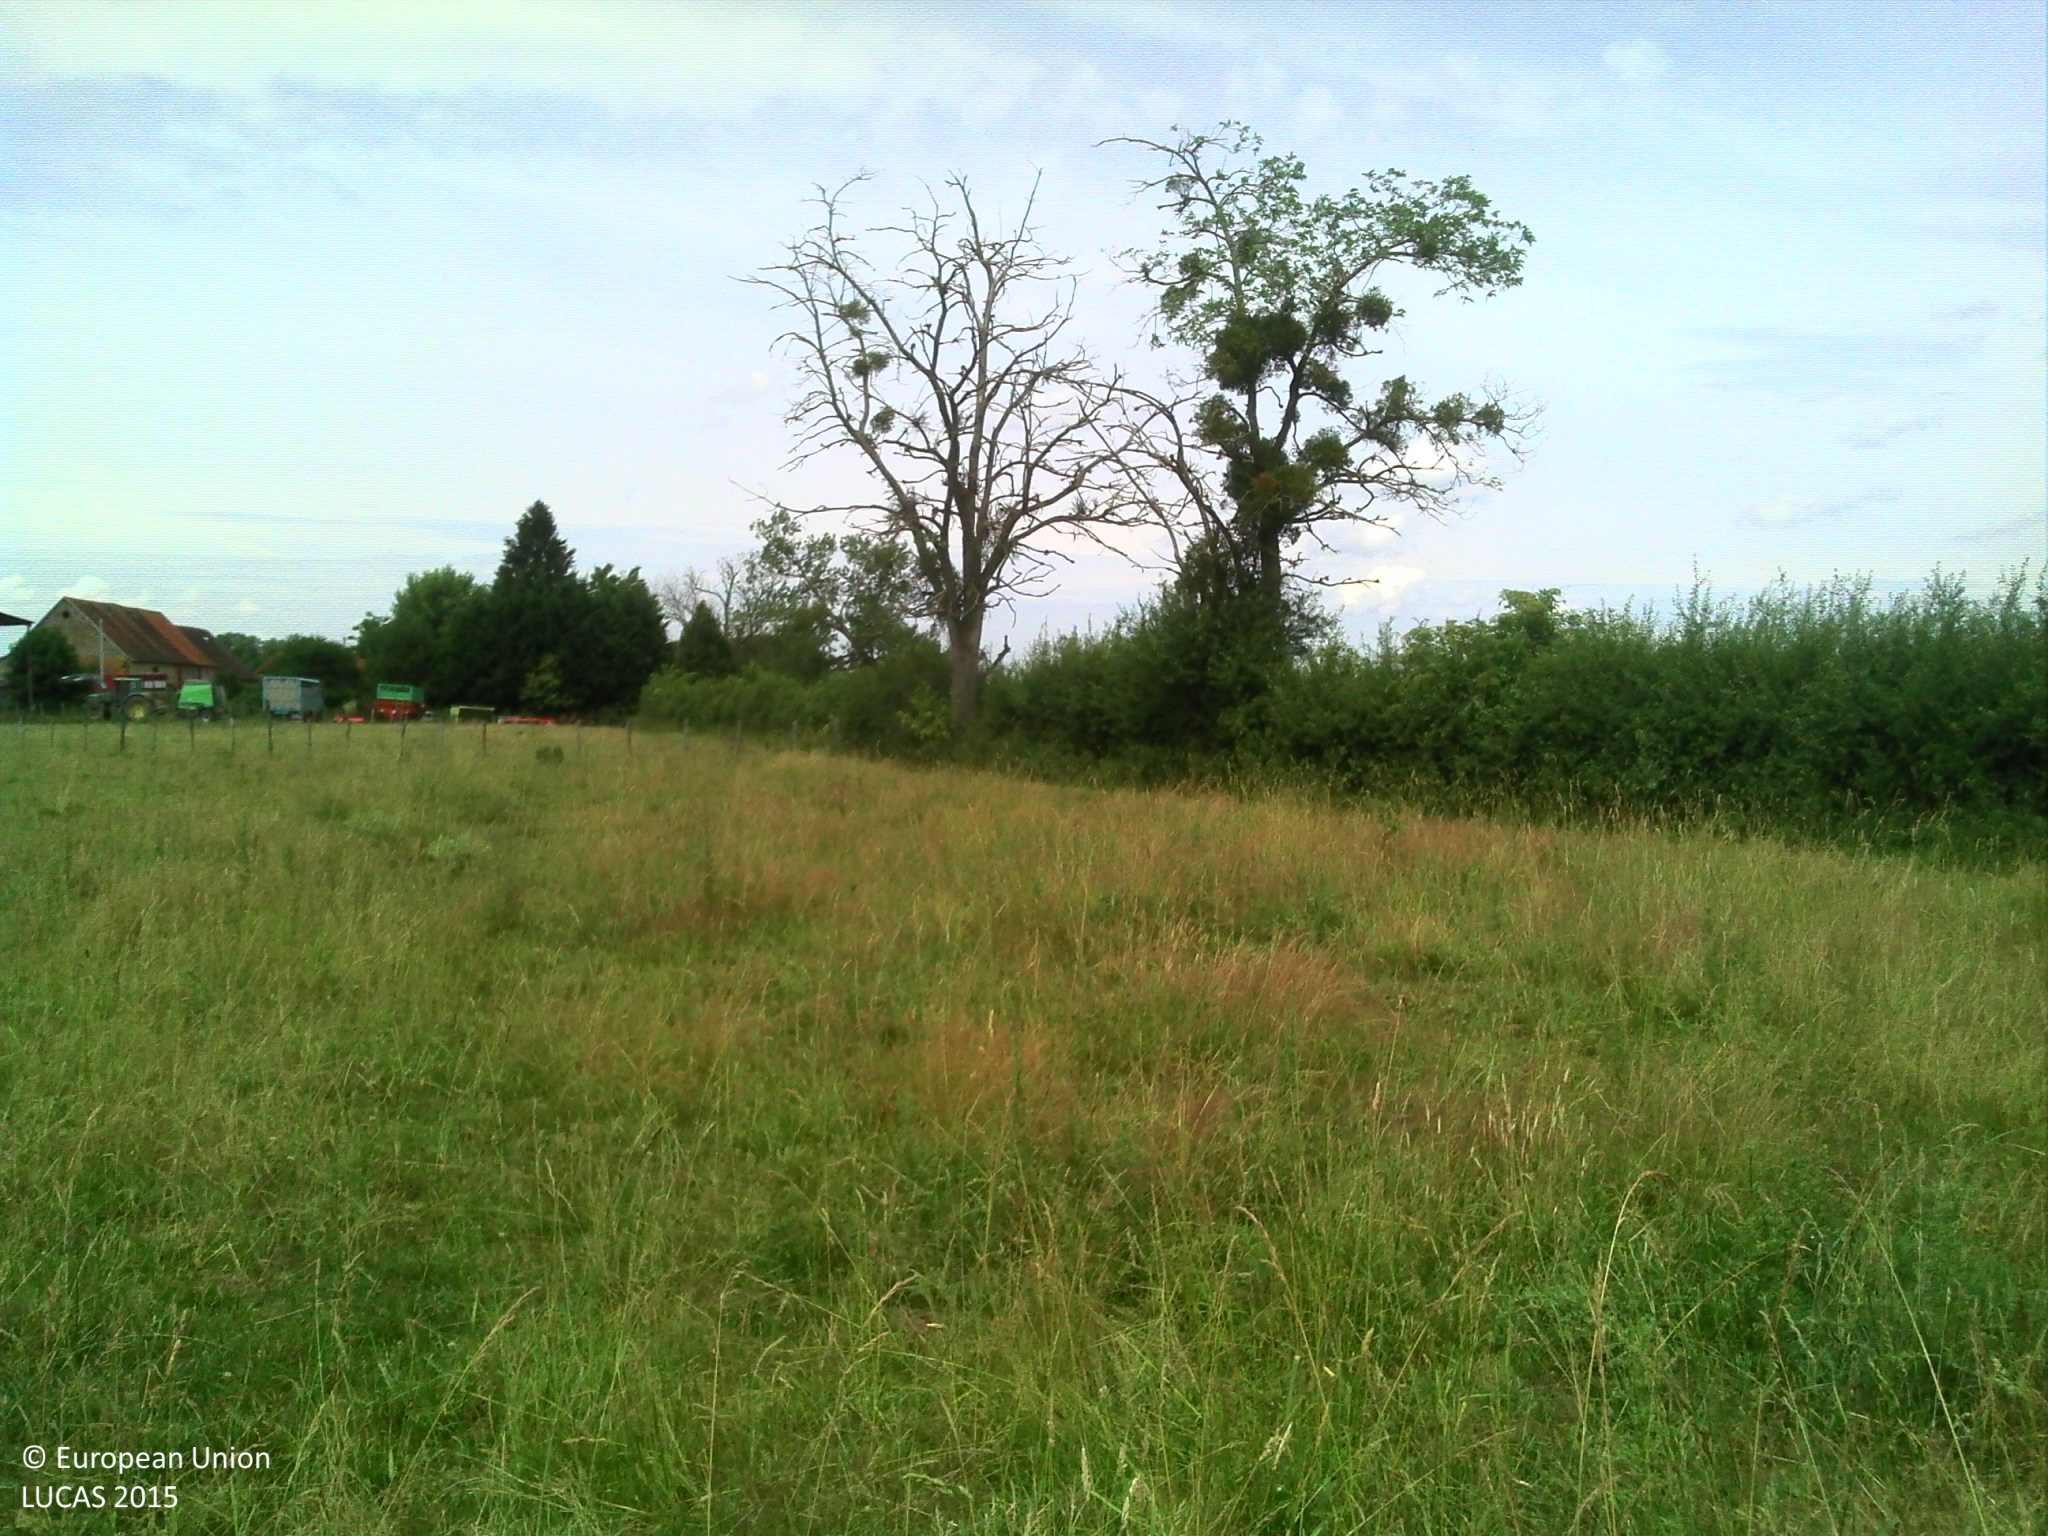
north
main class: Grassland
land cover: Grassland without tree/shrub cover
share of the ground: > 75 %
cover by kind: herbaceous plants 100 %
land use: Agriculture (excluding fallow land and kitchen gardens)
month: June
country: FR
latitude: 46.3100
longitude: 4.0146
